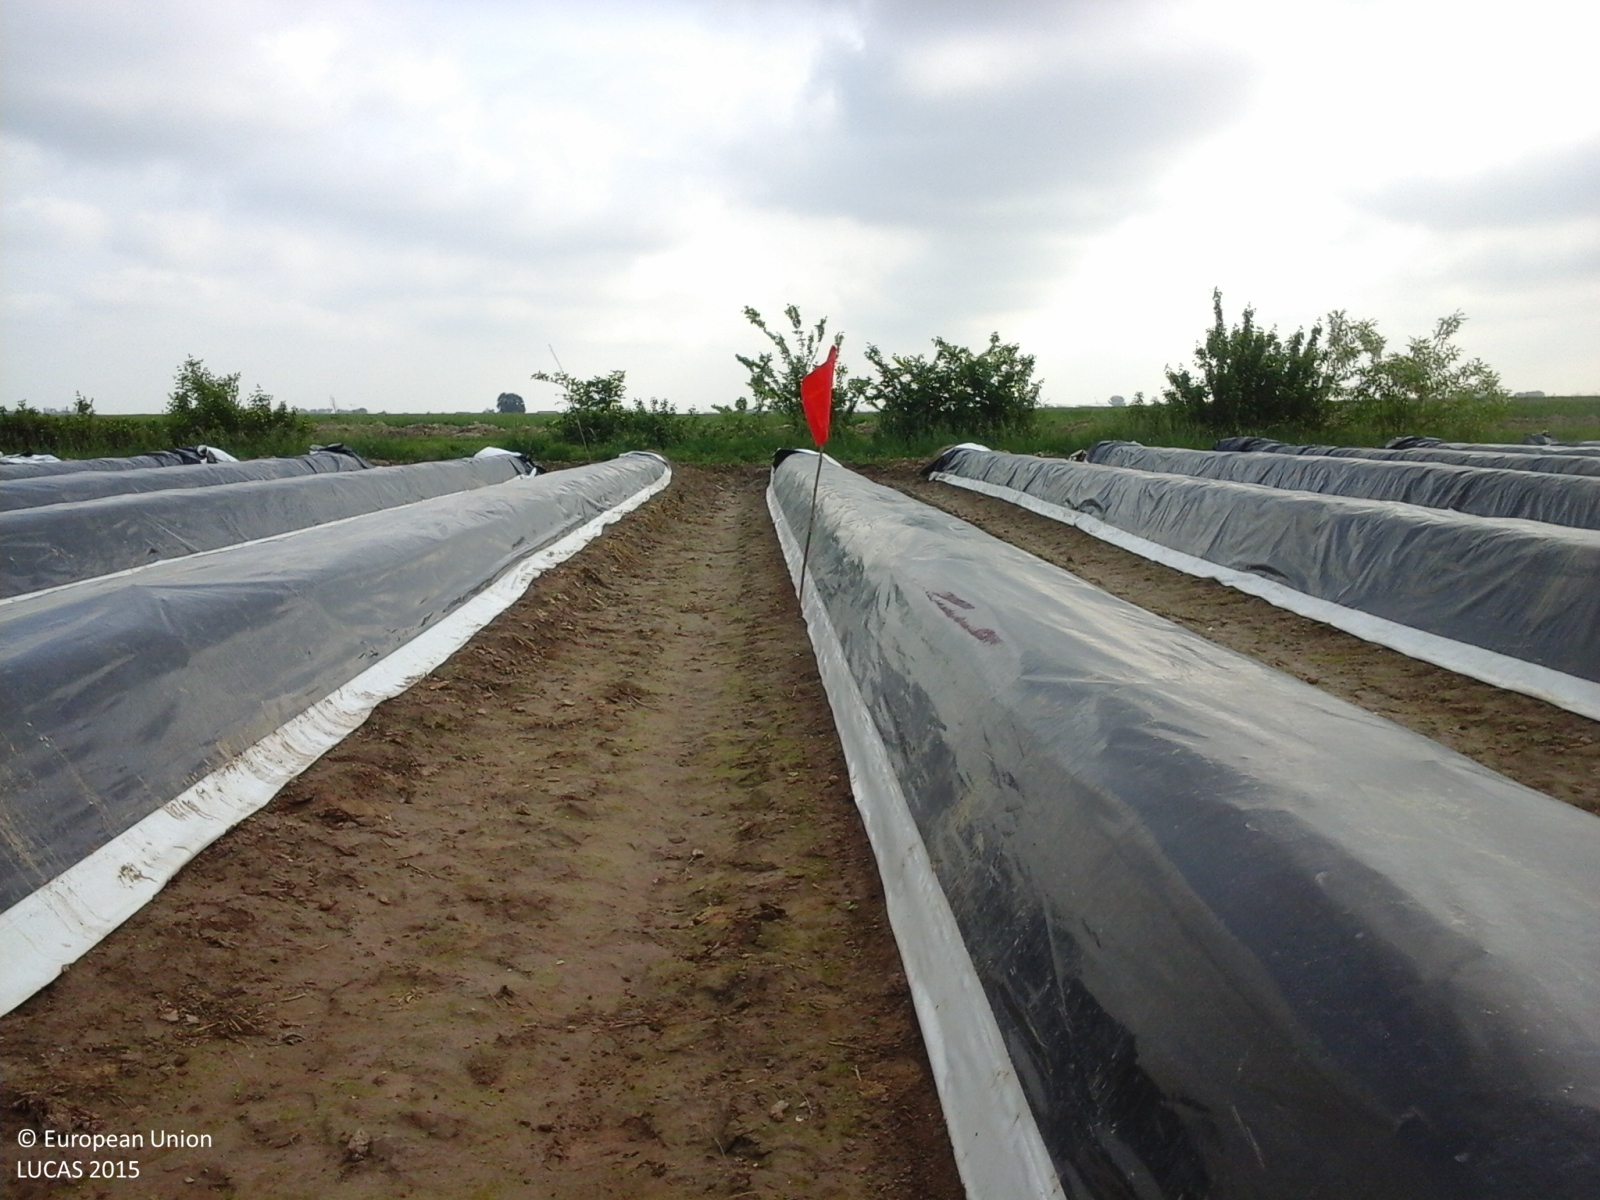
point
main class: Cropland
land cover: Other fresh vegetables
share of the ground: < 10 %
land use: Agriculture (excluding fallow land and kitchen gardens)
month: May
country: IT
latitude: 45.0058
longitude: 11.5829
